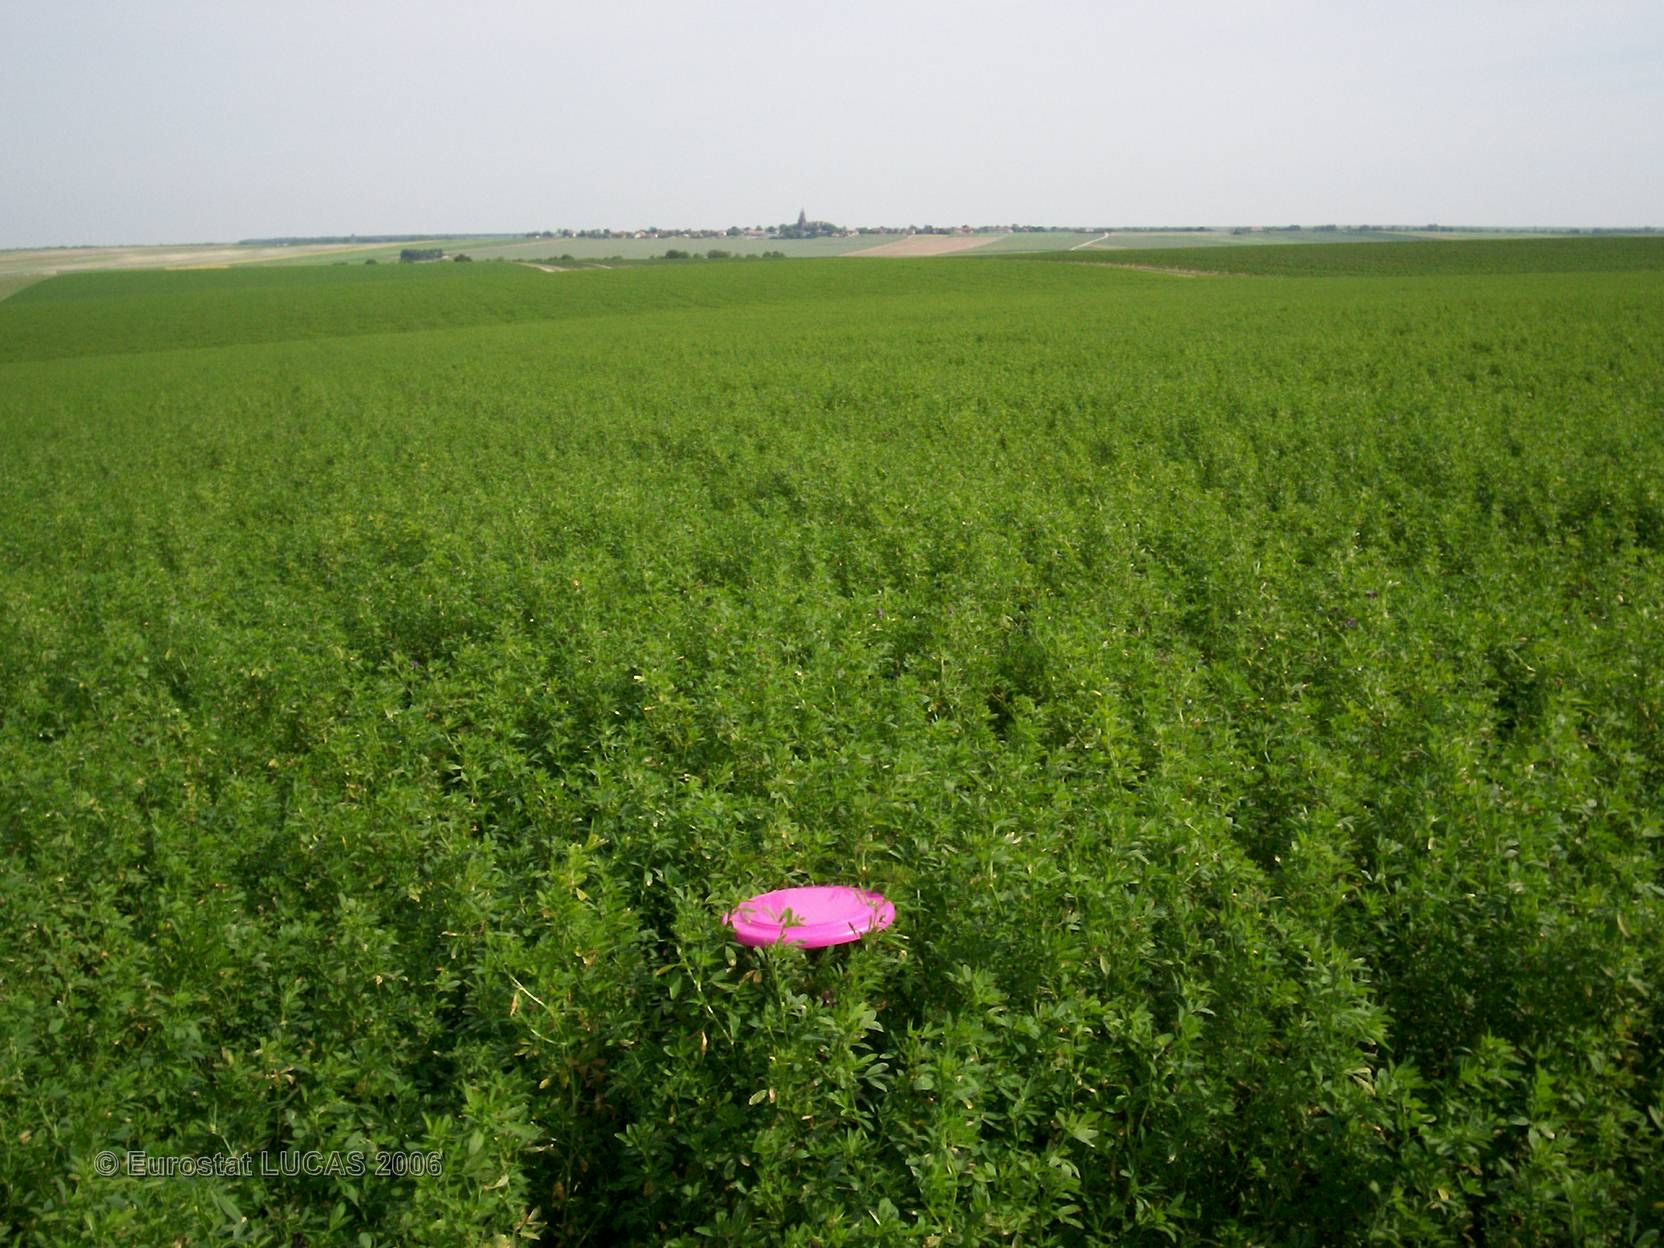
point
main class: Cropland
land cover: Lucerne
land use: Agriculture (excluding fallow land and kitchen gardens)
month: June
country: FR
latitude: 48.9502
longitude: 4.4662
